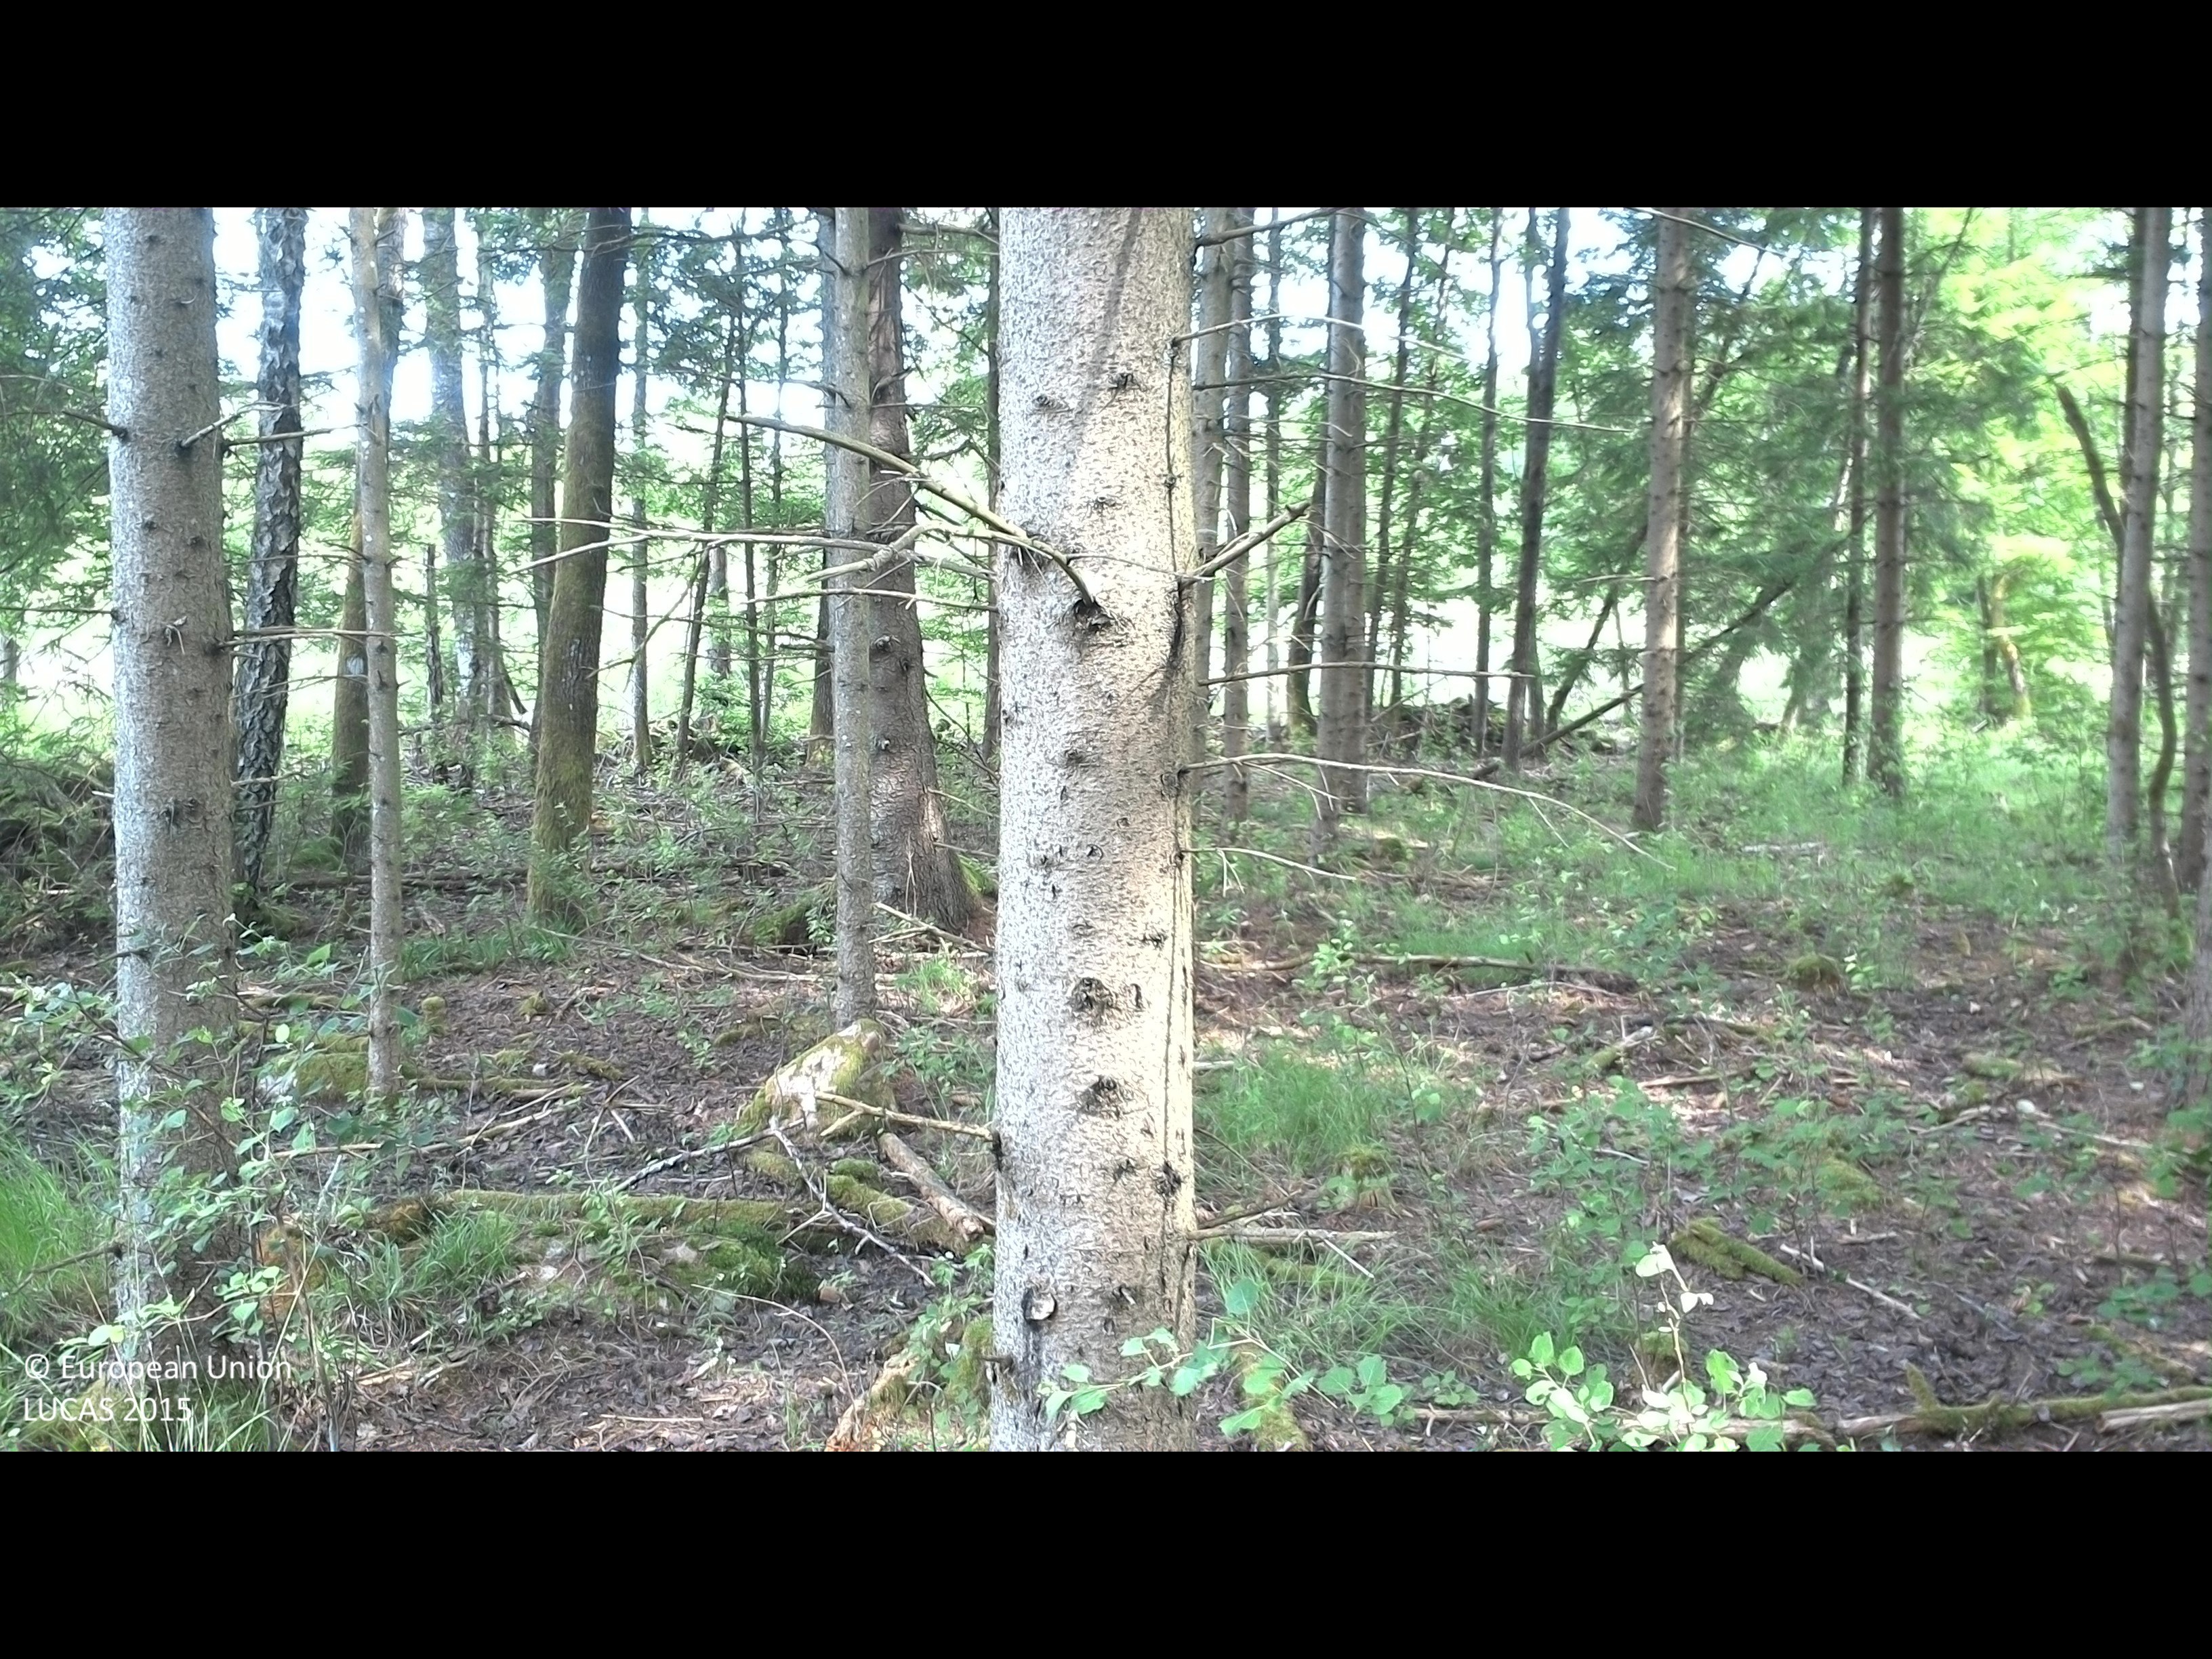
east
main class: Woodland
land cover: Spruce dominated coniferous woodland
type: boreal forest
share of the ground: 50 - 75 %
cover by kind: coniferous forest trees 65 %, lichens and mosses 15 %, broadleaved forest trees 10 %, herbaceous plants 5 %, unconsolidated bare surface 5 %
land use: Forestry
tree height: > 5 m
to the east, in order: Spruce dominated coniferous woodland; Broadleaved woodland; Spruce dominated coniferous woodland; Broadleaved woodland; Spruce dominated coniferous woodland
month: July
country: SE
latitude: 56.3271
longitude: 15.3843
